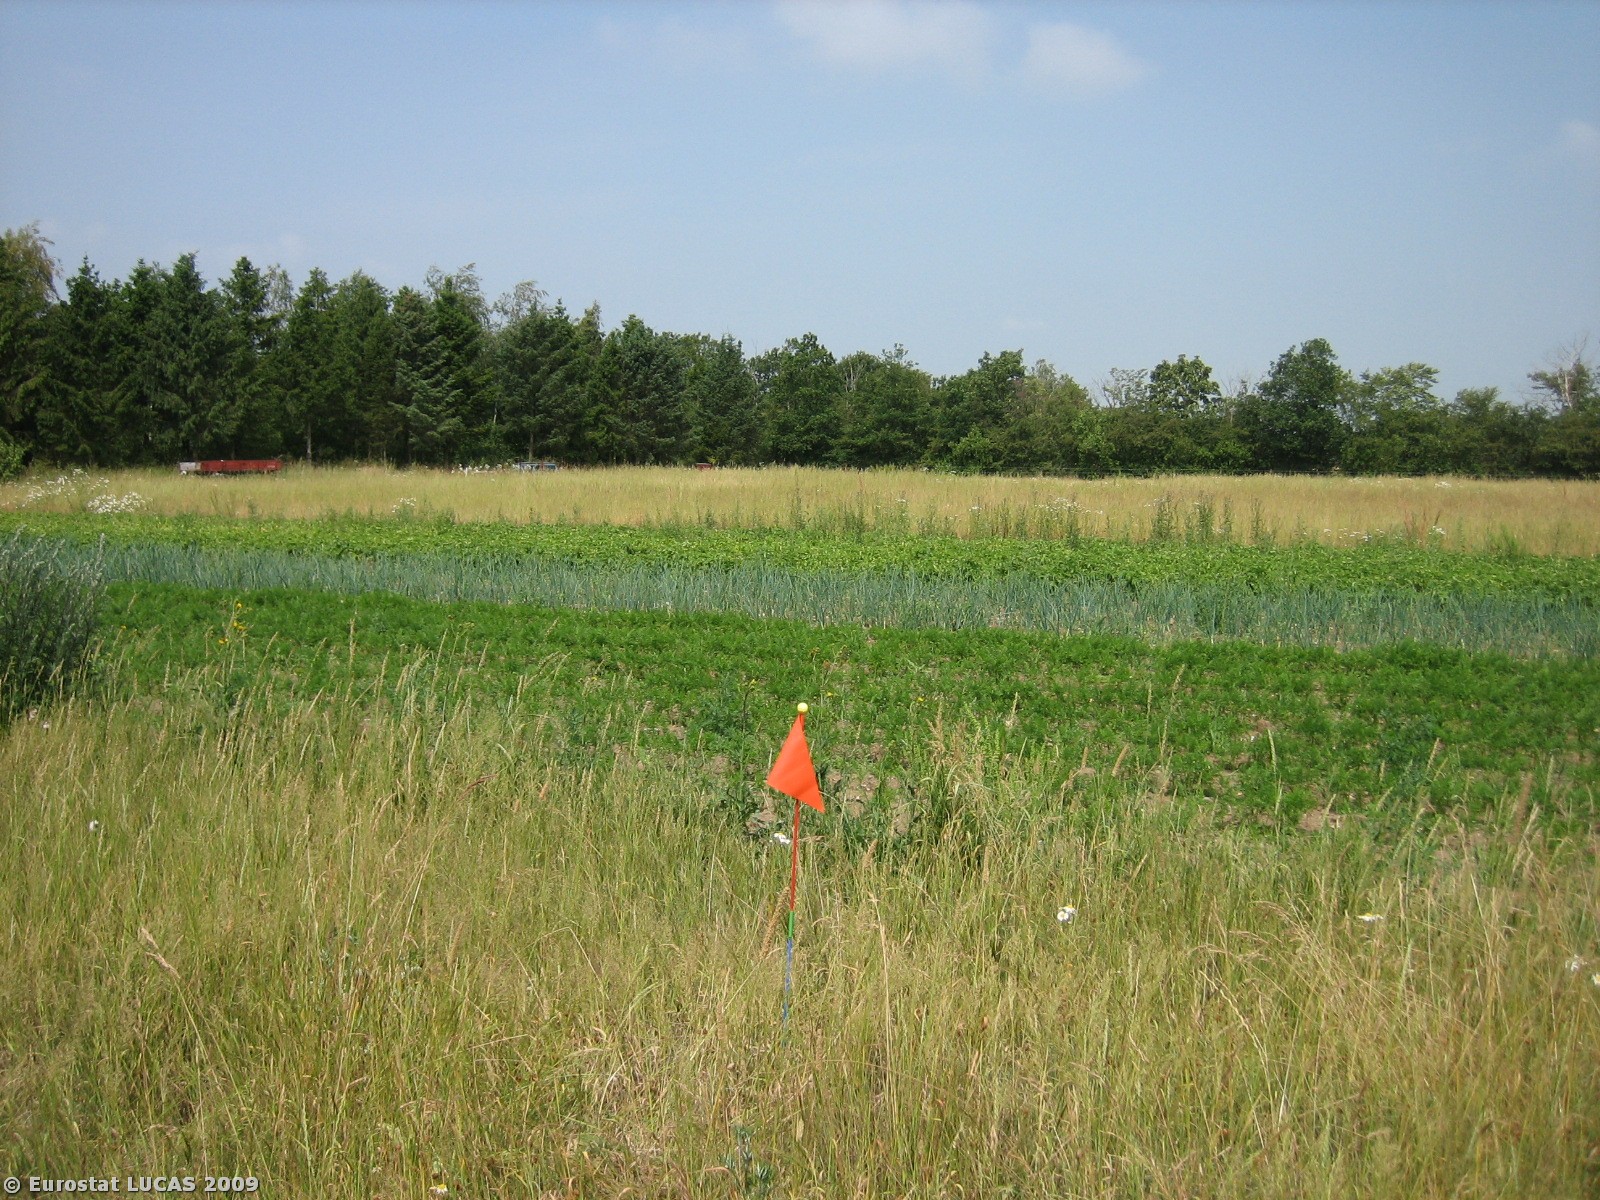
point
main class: Grassland
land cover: Grassland without tree/shrub cover
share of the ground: > 75 %
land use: Agriculture (excluding fallow land and kitchen gardens)
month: July
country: DK
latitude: 55.4985
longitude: 8.7506
